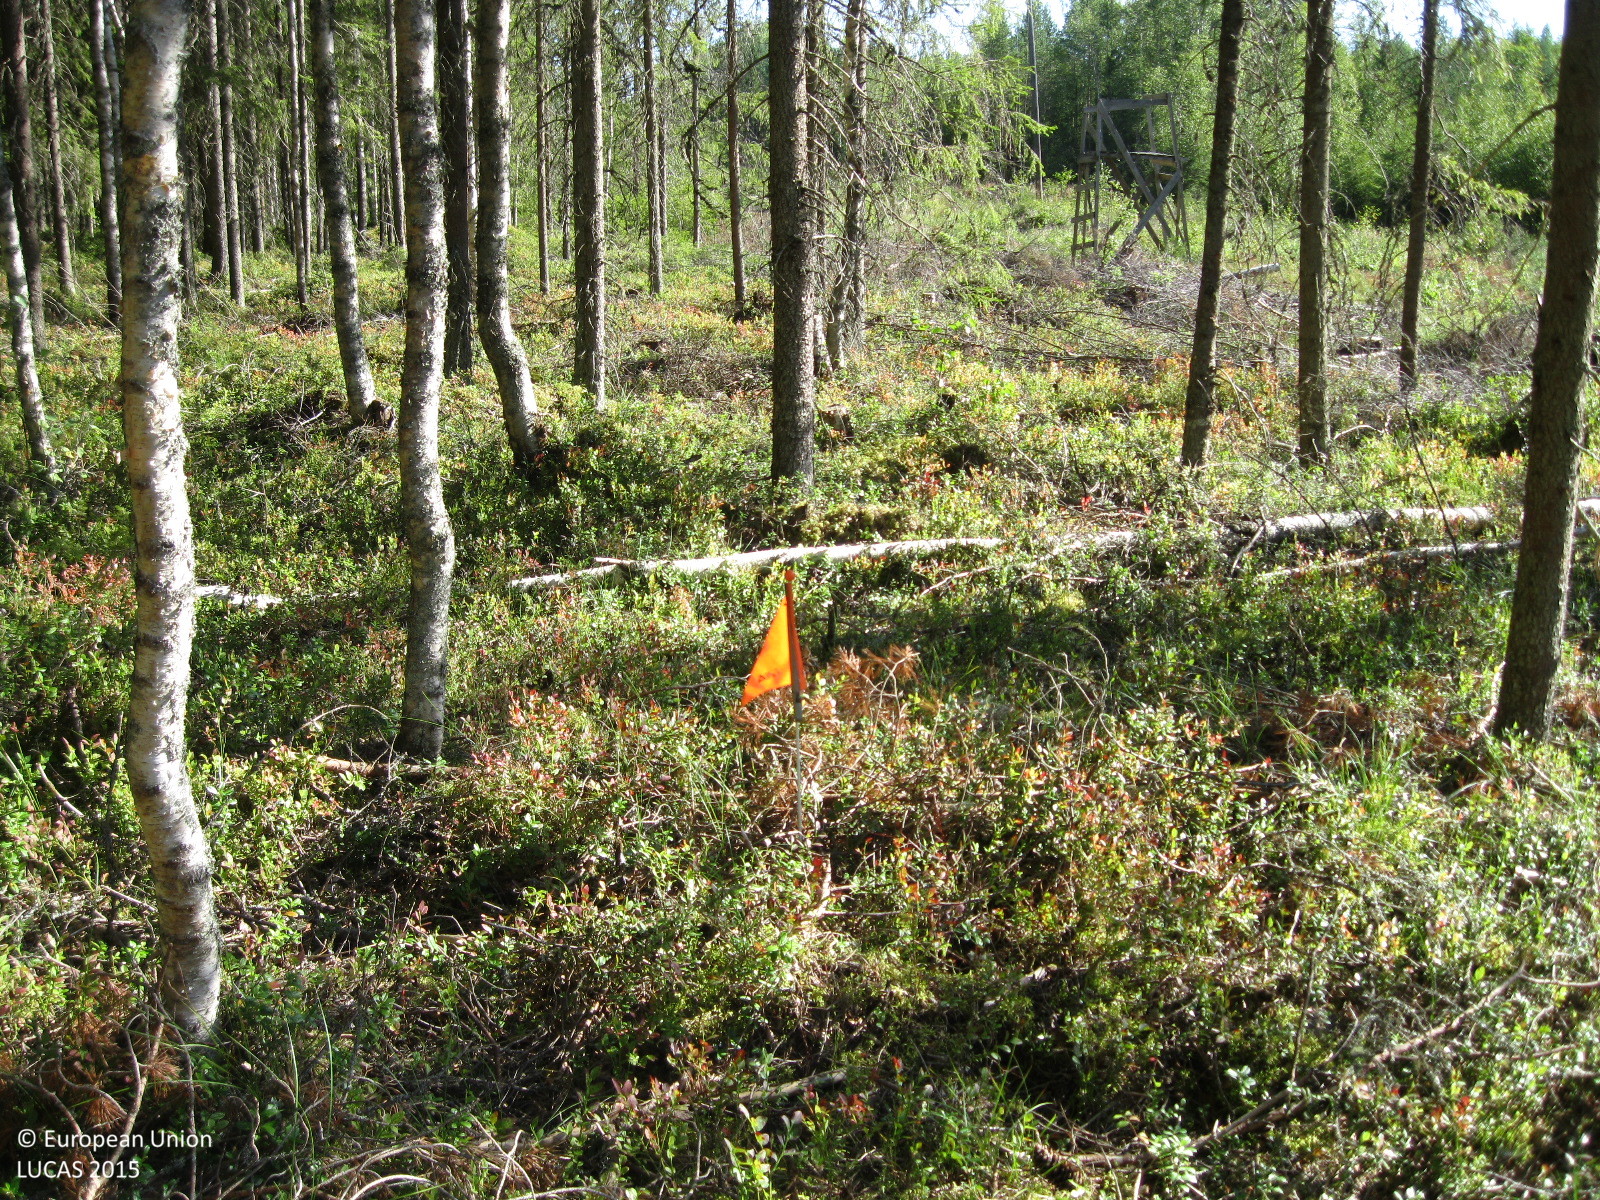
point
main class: Woodland
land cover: Other mixed woodland
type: boreal forest
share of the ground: > 75 %
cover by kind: coniferous forest trees 55 %, broadleaved forest trees 30 %, shrubs 15 %
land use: Forestry
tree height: > 5 m
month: August
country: FI
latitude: 61.2552
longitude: 25.2725
